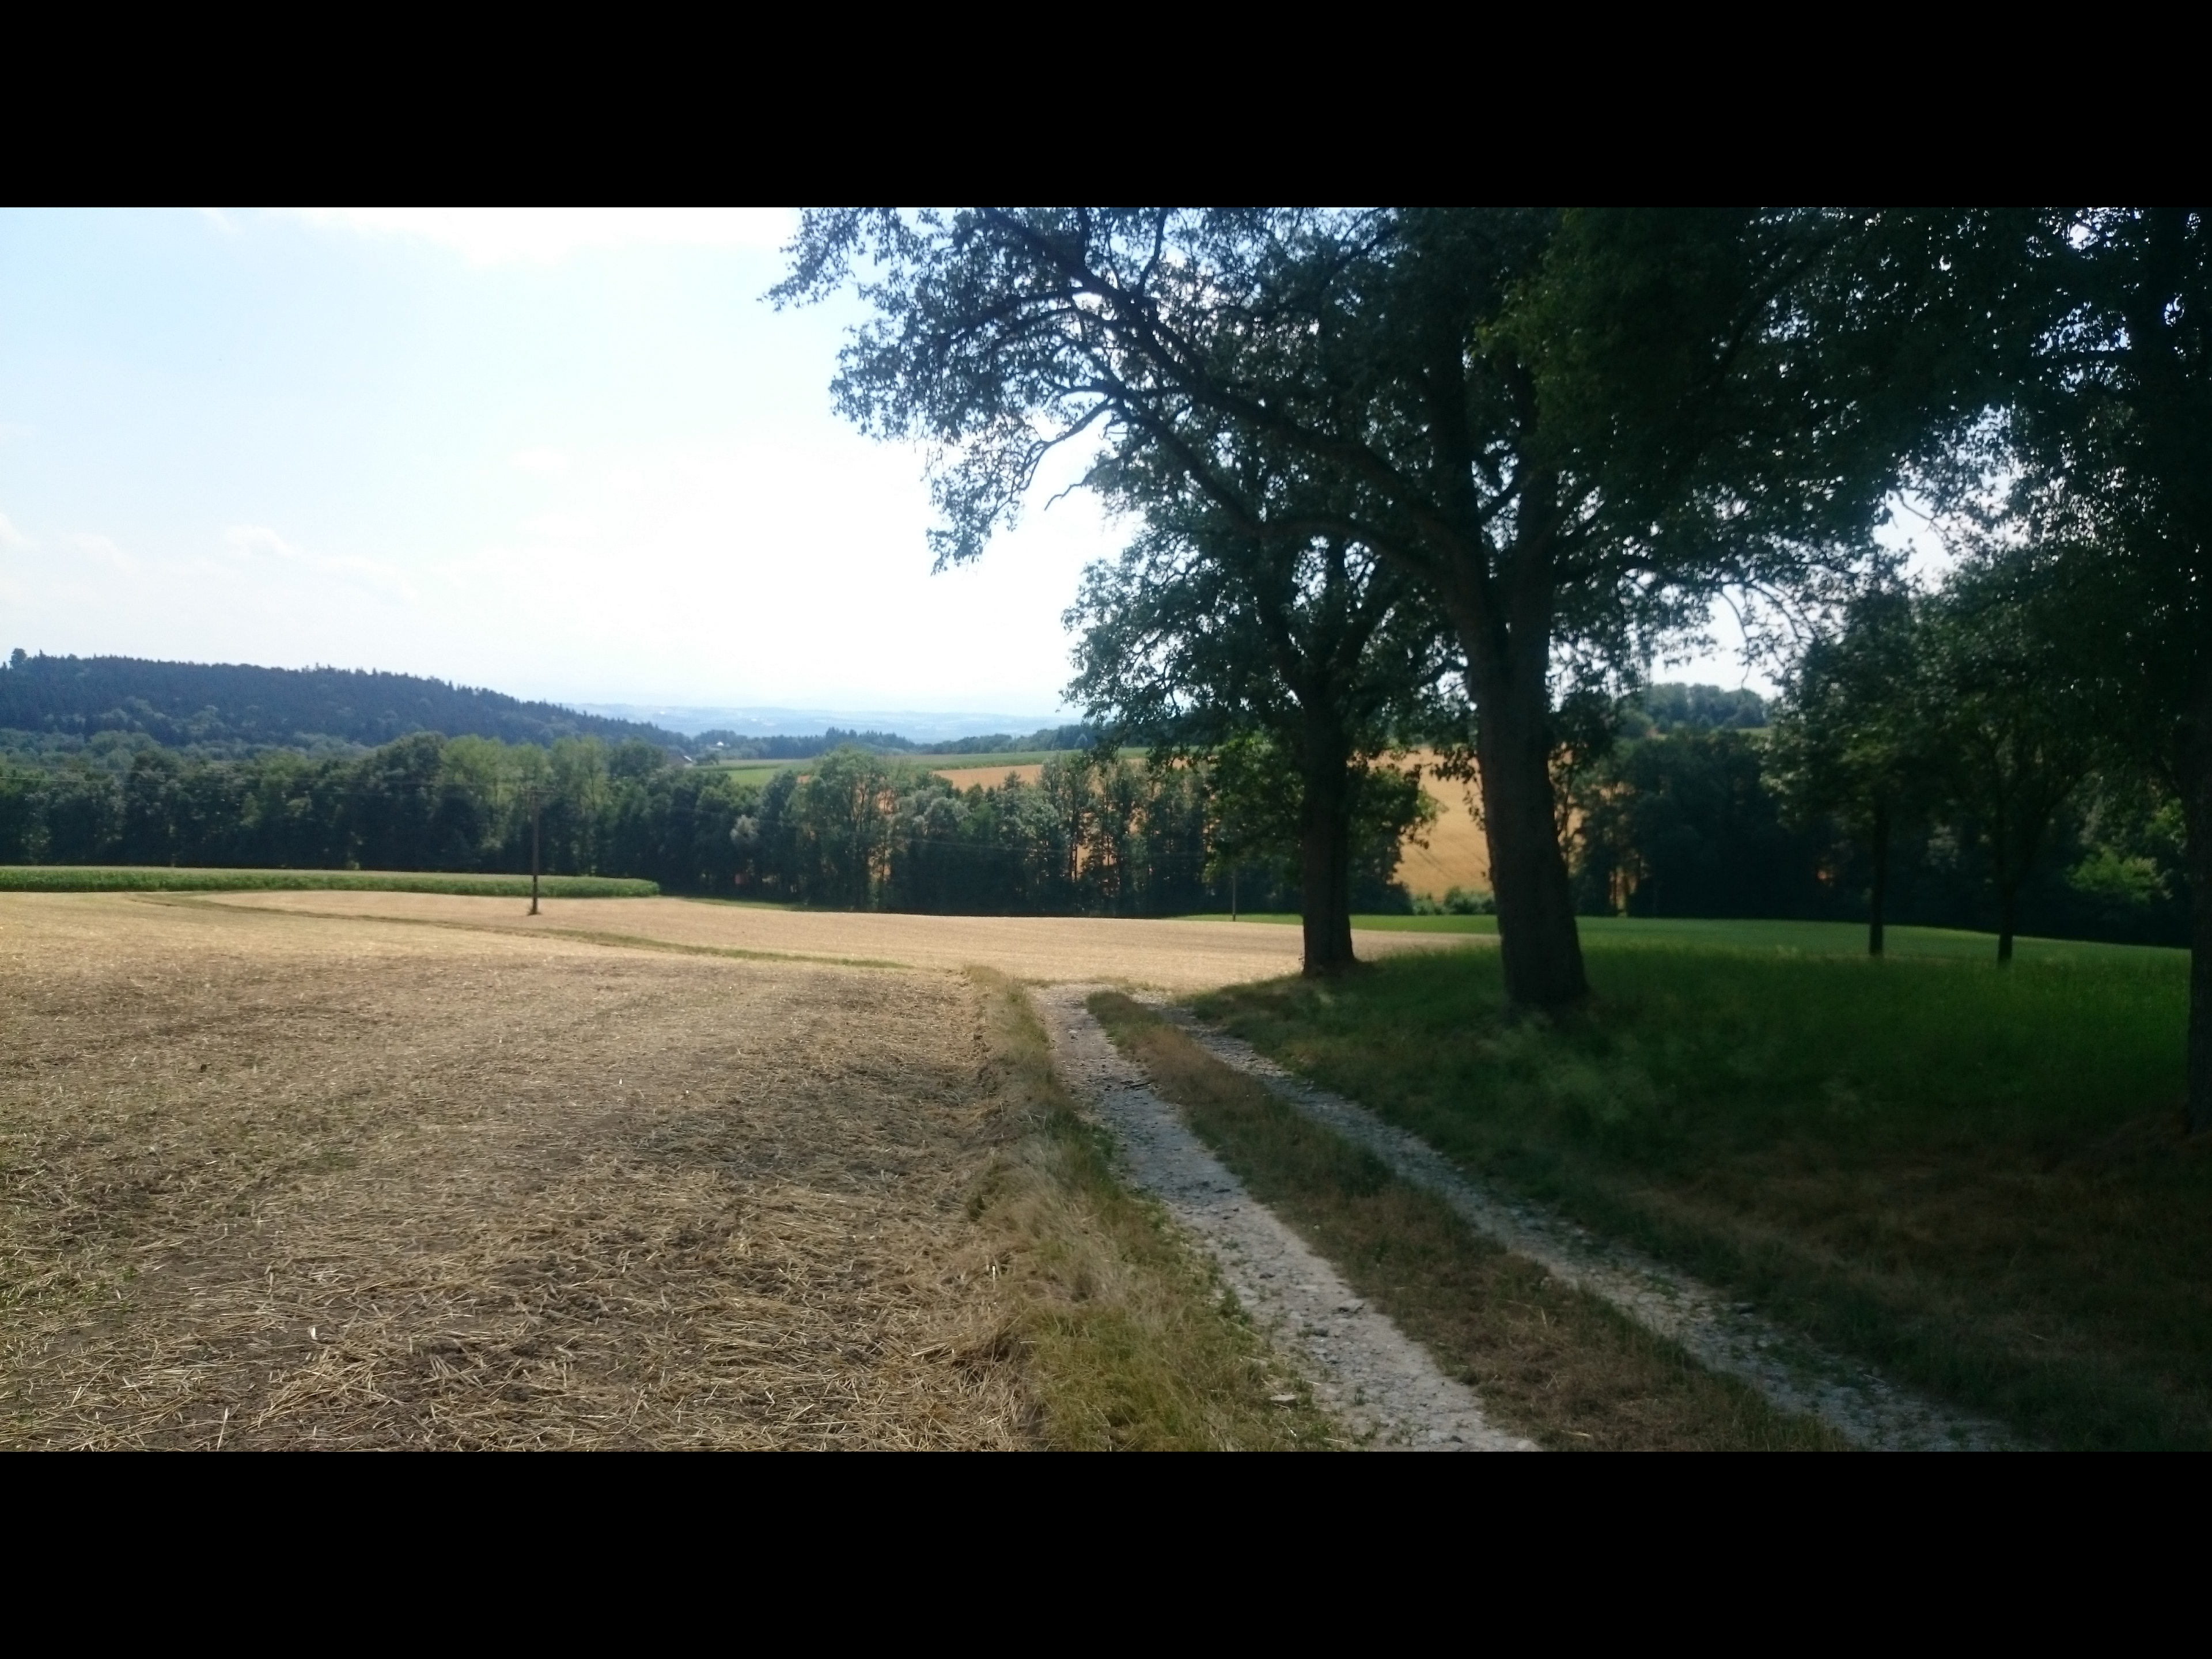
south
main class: Cropland
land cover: Barley
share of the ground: < 10 %
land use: Agriculture (excluding fallow land and kitchen gardens)
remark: Harvested field
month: July
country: AT
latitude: 48.2269
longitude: 14.8066
